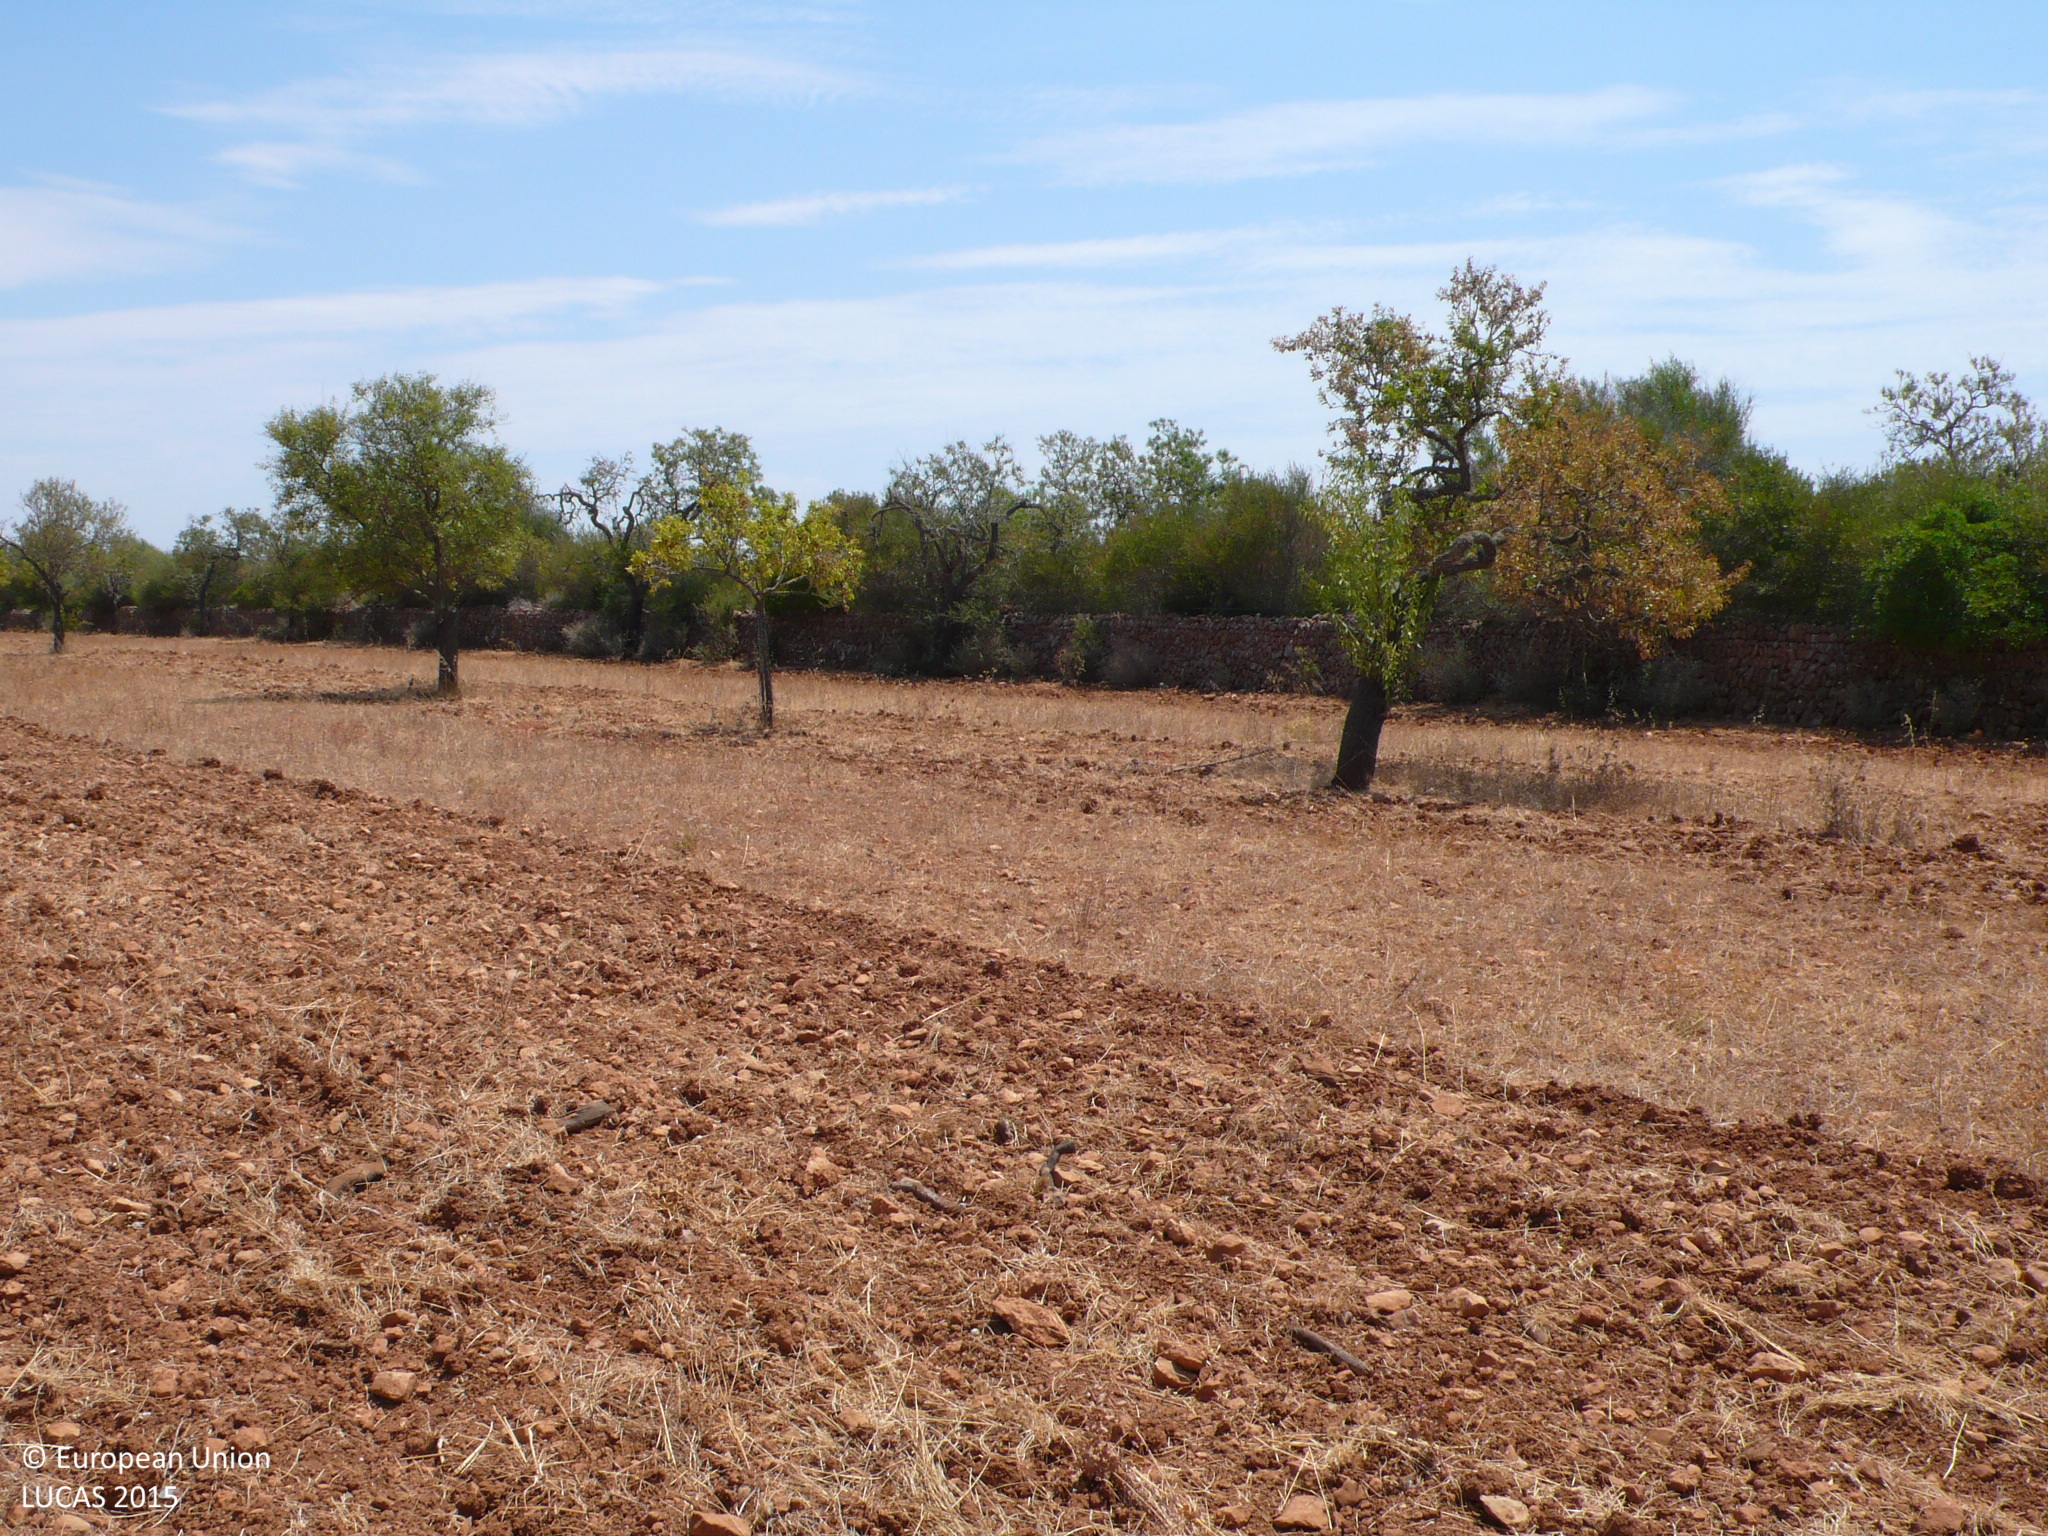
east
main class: Cropland
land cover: Nuts trees
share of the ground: 10 - 25 %
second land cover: Spontaneously vegetated surfaces
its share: 10 - 25 %
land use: Agriculture (excluding fallow land and kitchen gardens)
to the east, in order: Nuts trees; Spontaneously vegetated surfaces; Dry stone walls; Abandoned hedges; Nuts trees; Abandoned hedges; Dry stone walls; Nuts trees
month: July
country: ES
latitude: 39.4044
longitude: 2.8199
